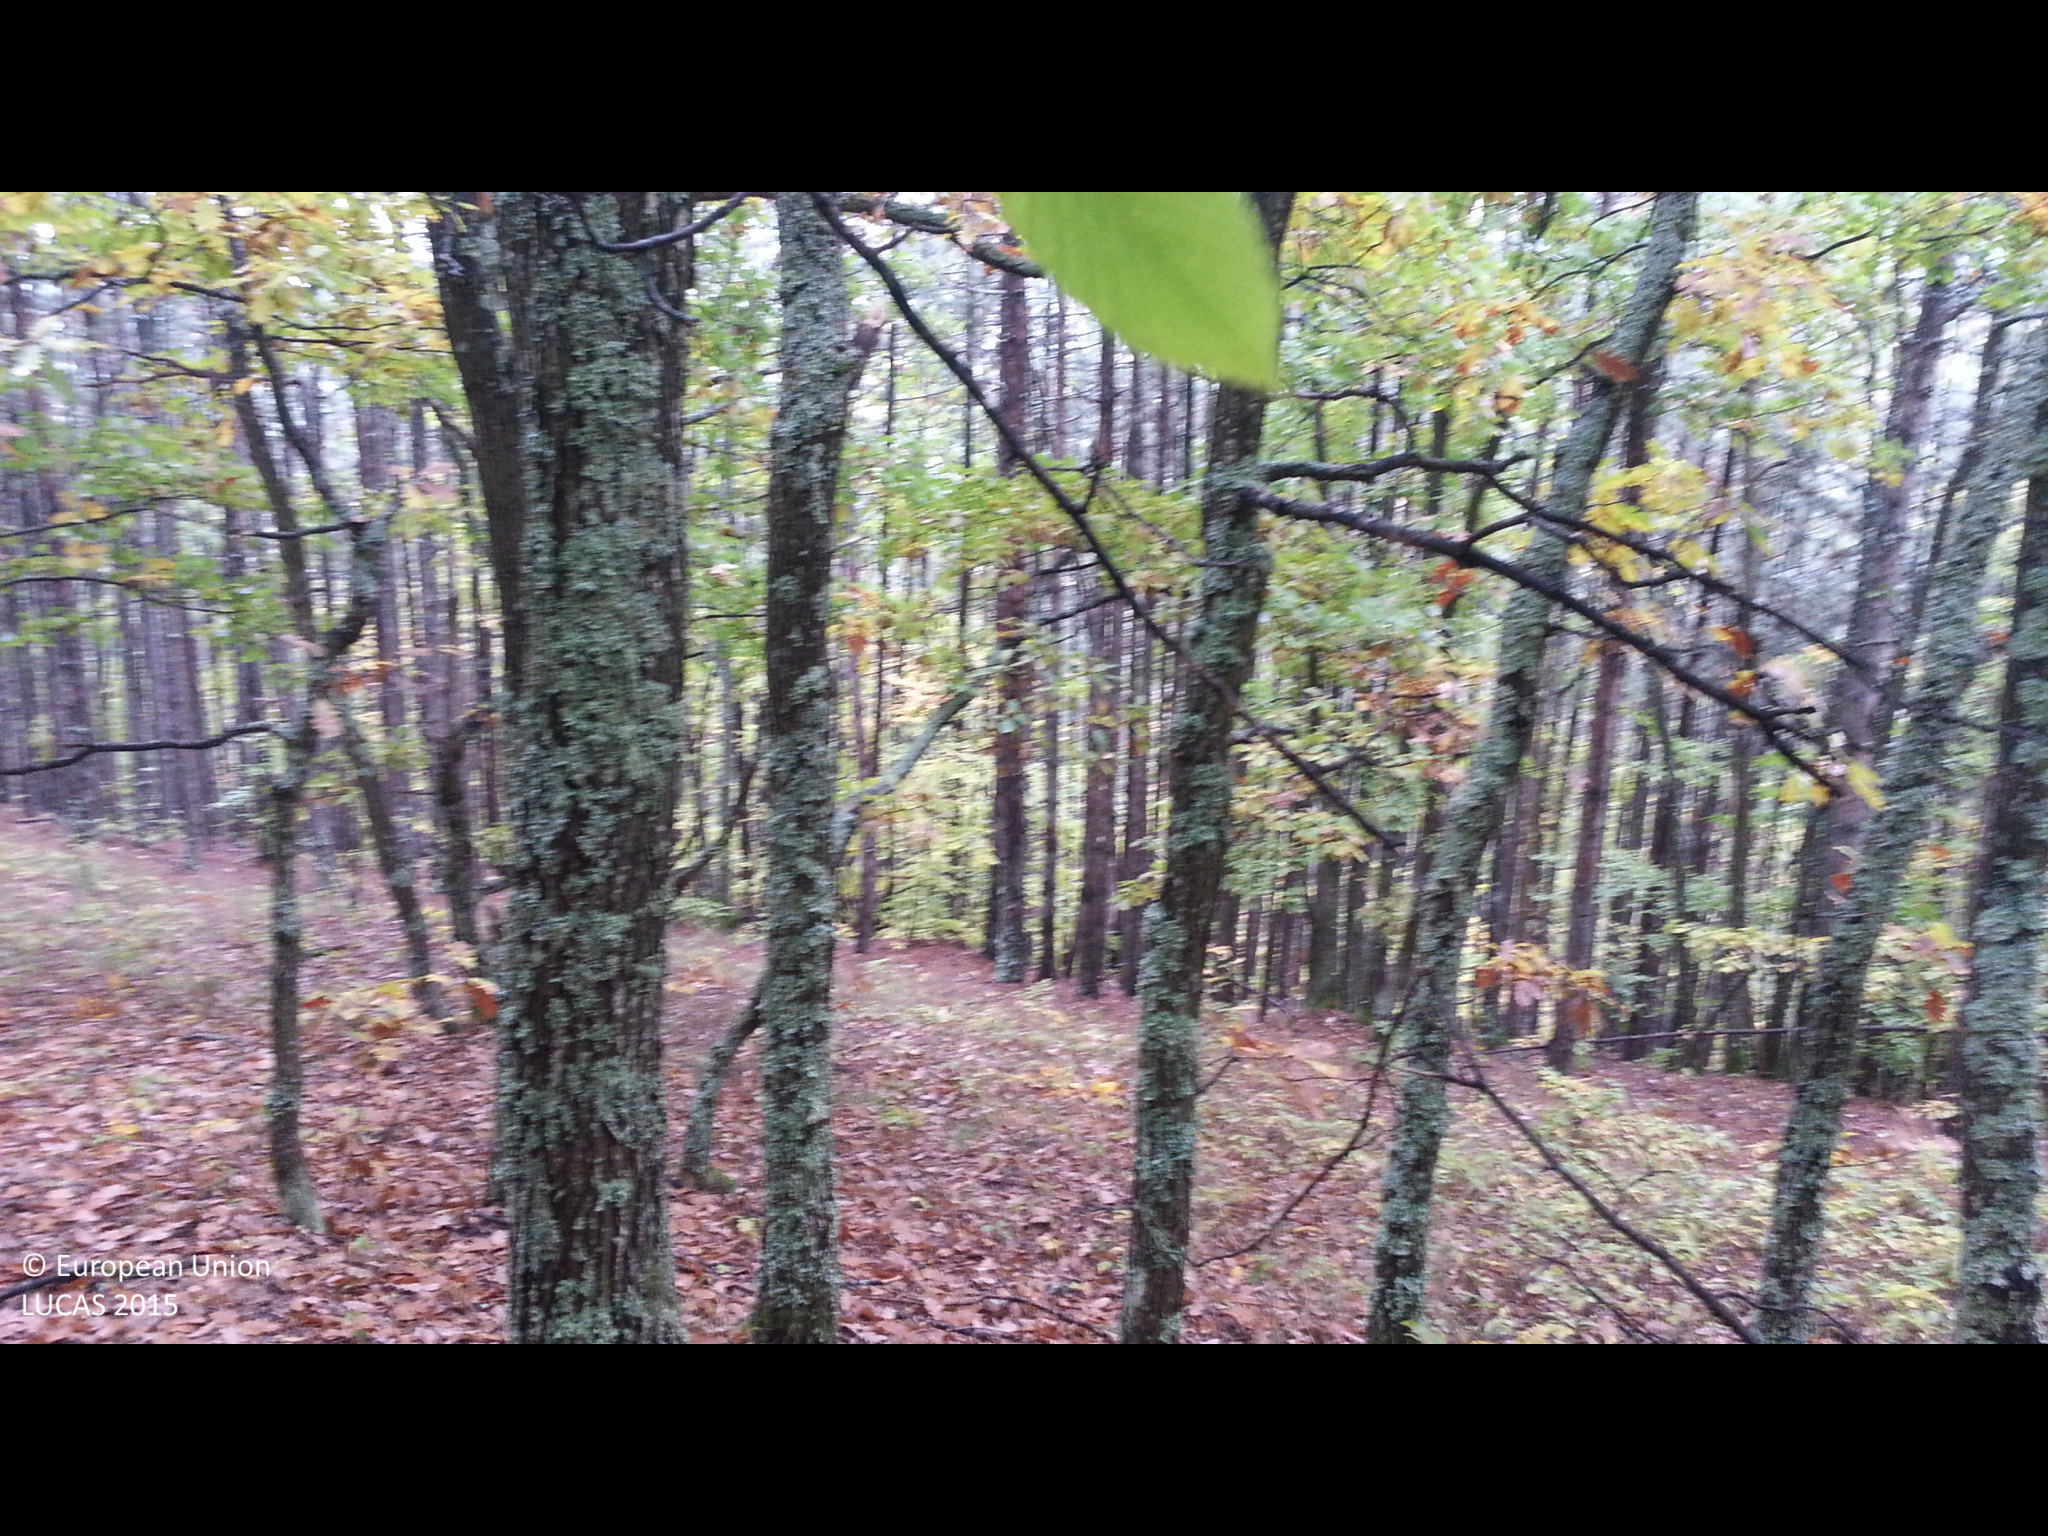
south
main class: Woodland
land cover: Broadleaved woodland
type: mesophytic deciduous forest
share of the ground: > 75 %
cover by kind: broadleaved forest trees 90 %, herbaceous plants 5 %, unconsolidated bare surface 5 %
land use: Forestry
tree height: > 5 m
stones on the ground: < 10 %
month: October
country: BG
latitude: 42.7432
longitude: 22.7189
